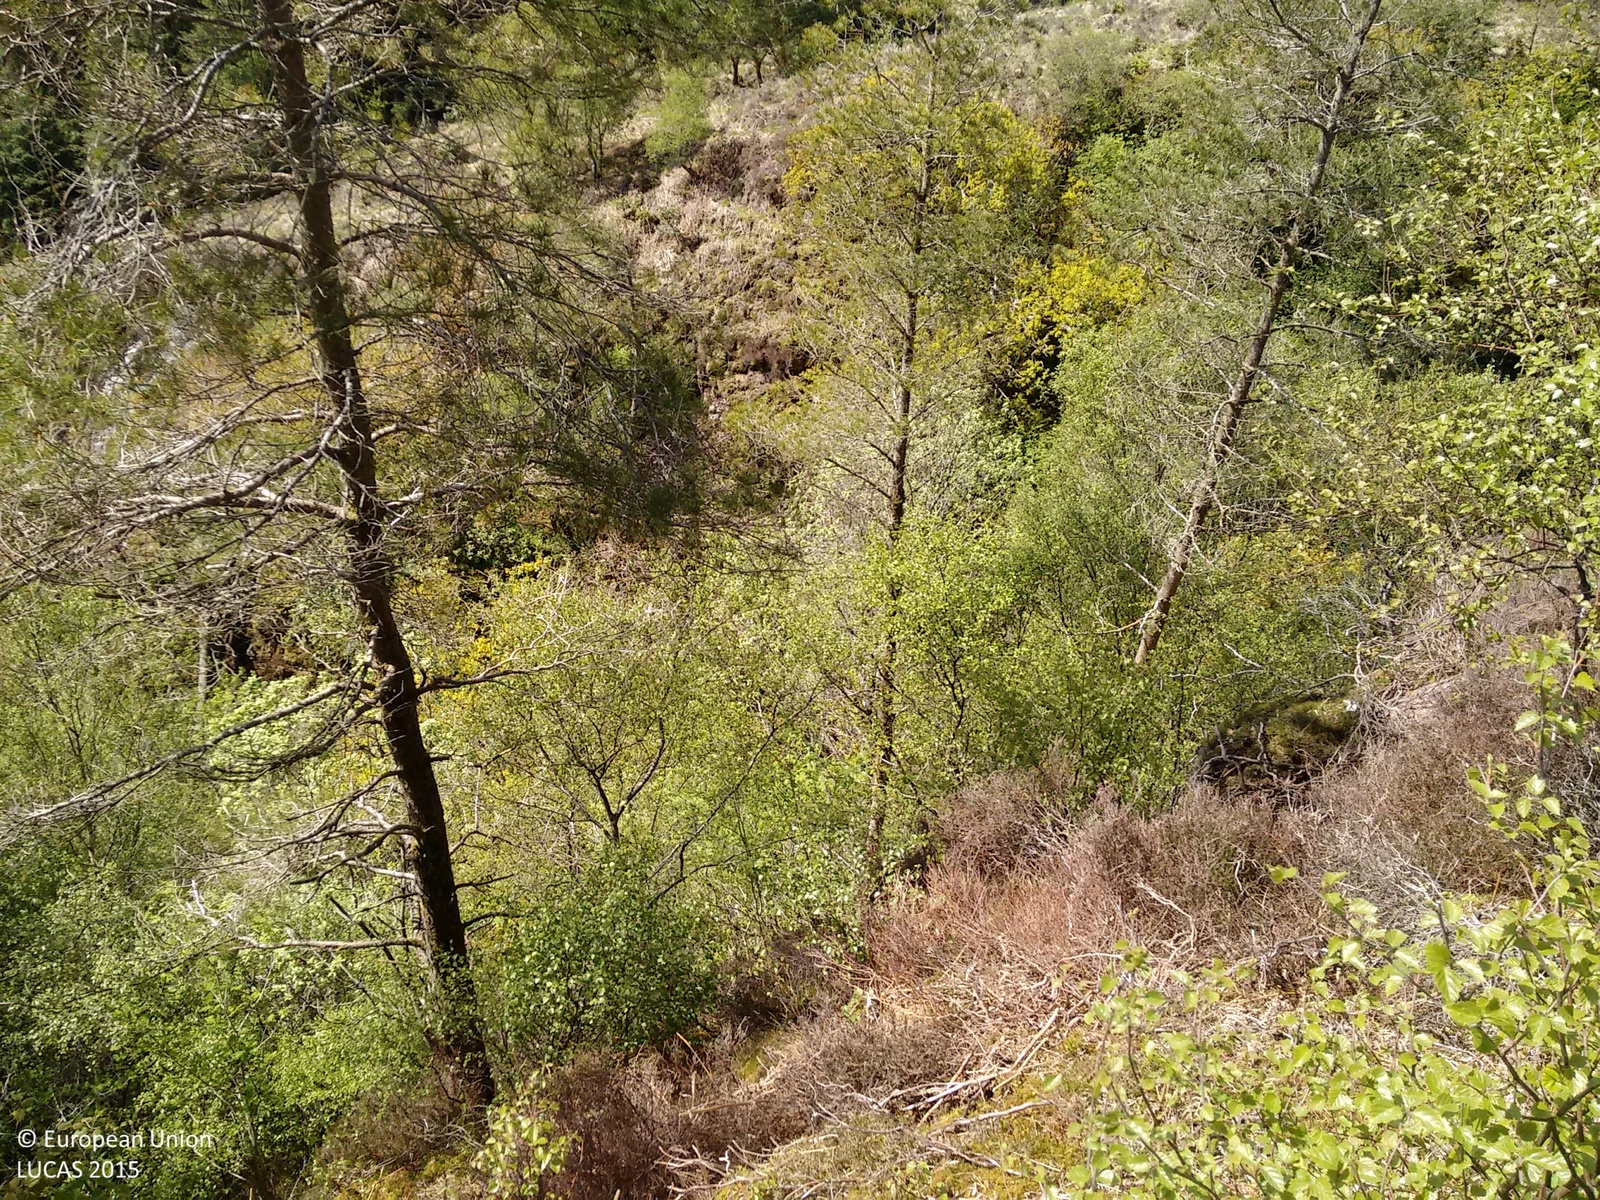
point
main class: Woodland
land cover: Broadleaved woodland
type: acidophilous oak and oak-birch forest
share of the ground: > 75 %
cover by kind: broadleaved forest trees 95 %, coniferous forest trees 5 %
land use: Semi-natural and natural areas not in use
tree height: > 5 m
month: May
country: GB
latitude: 55.9121
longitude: -5.2345
